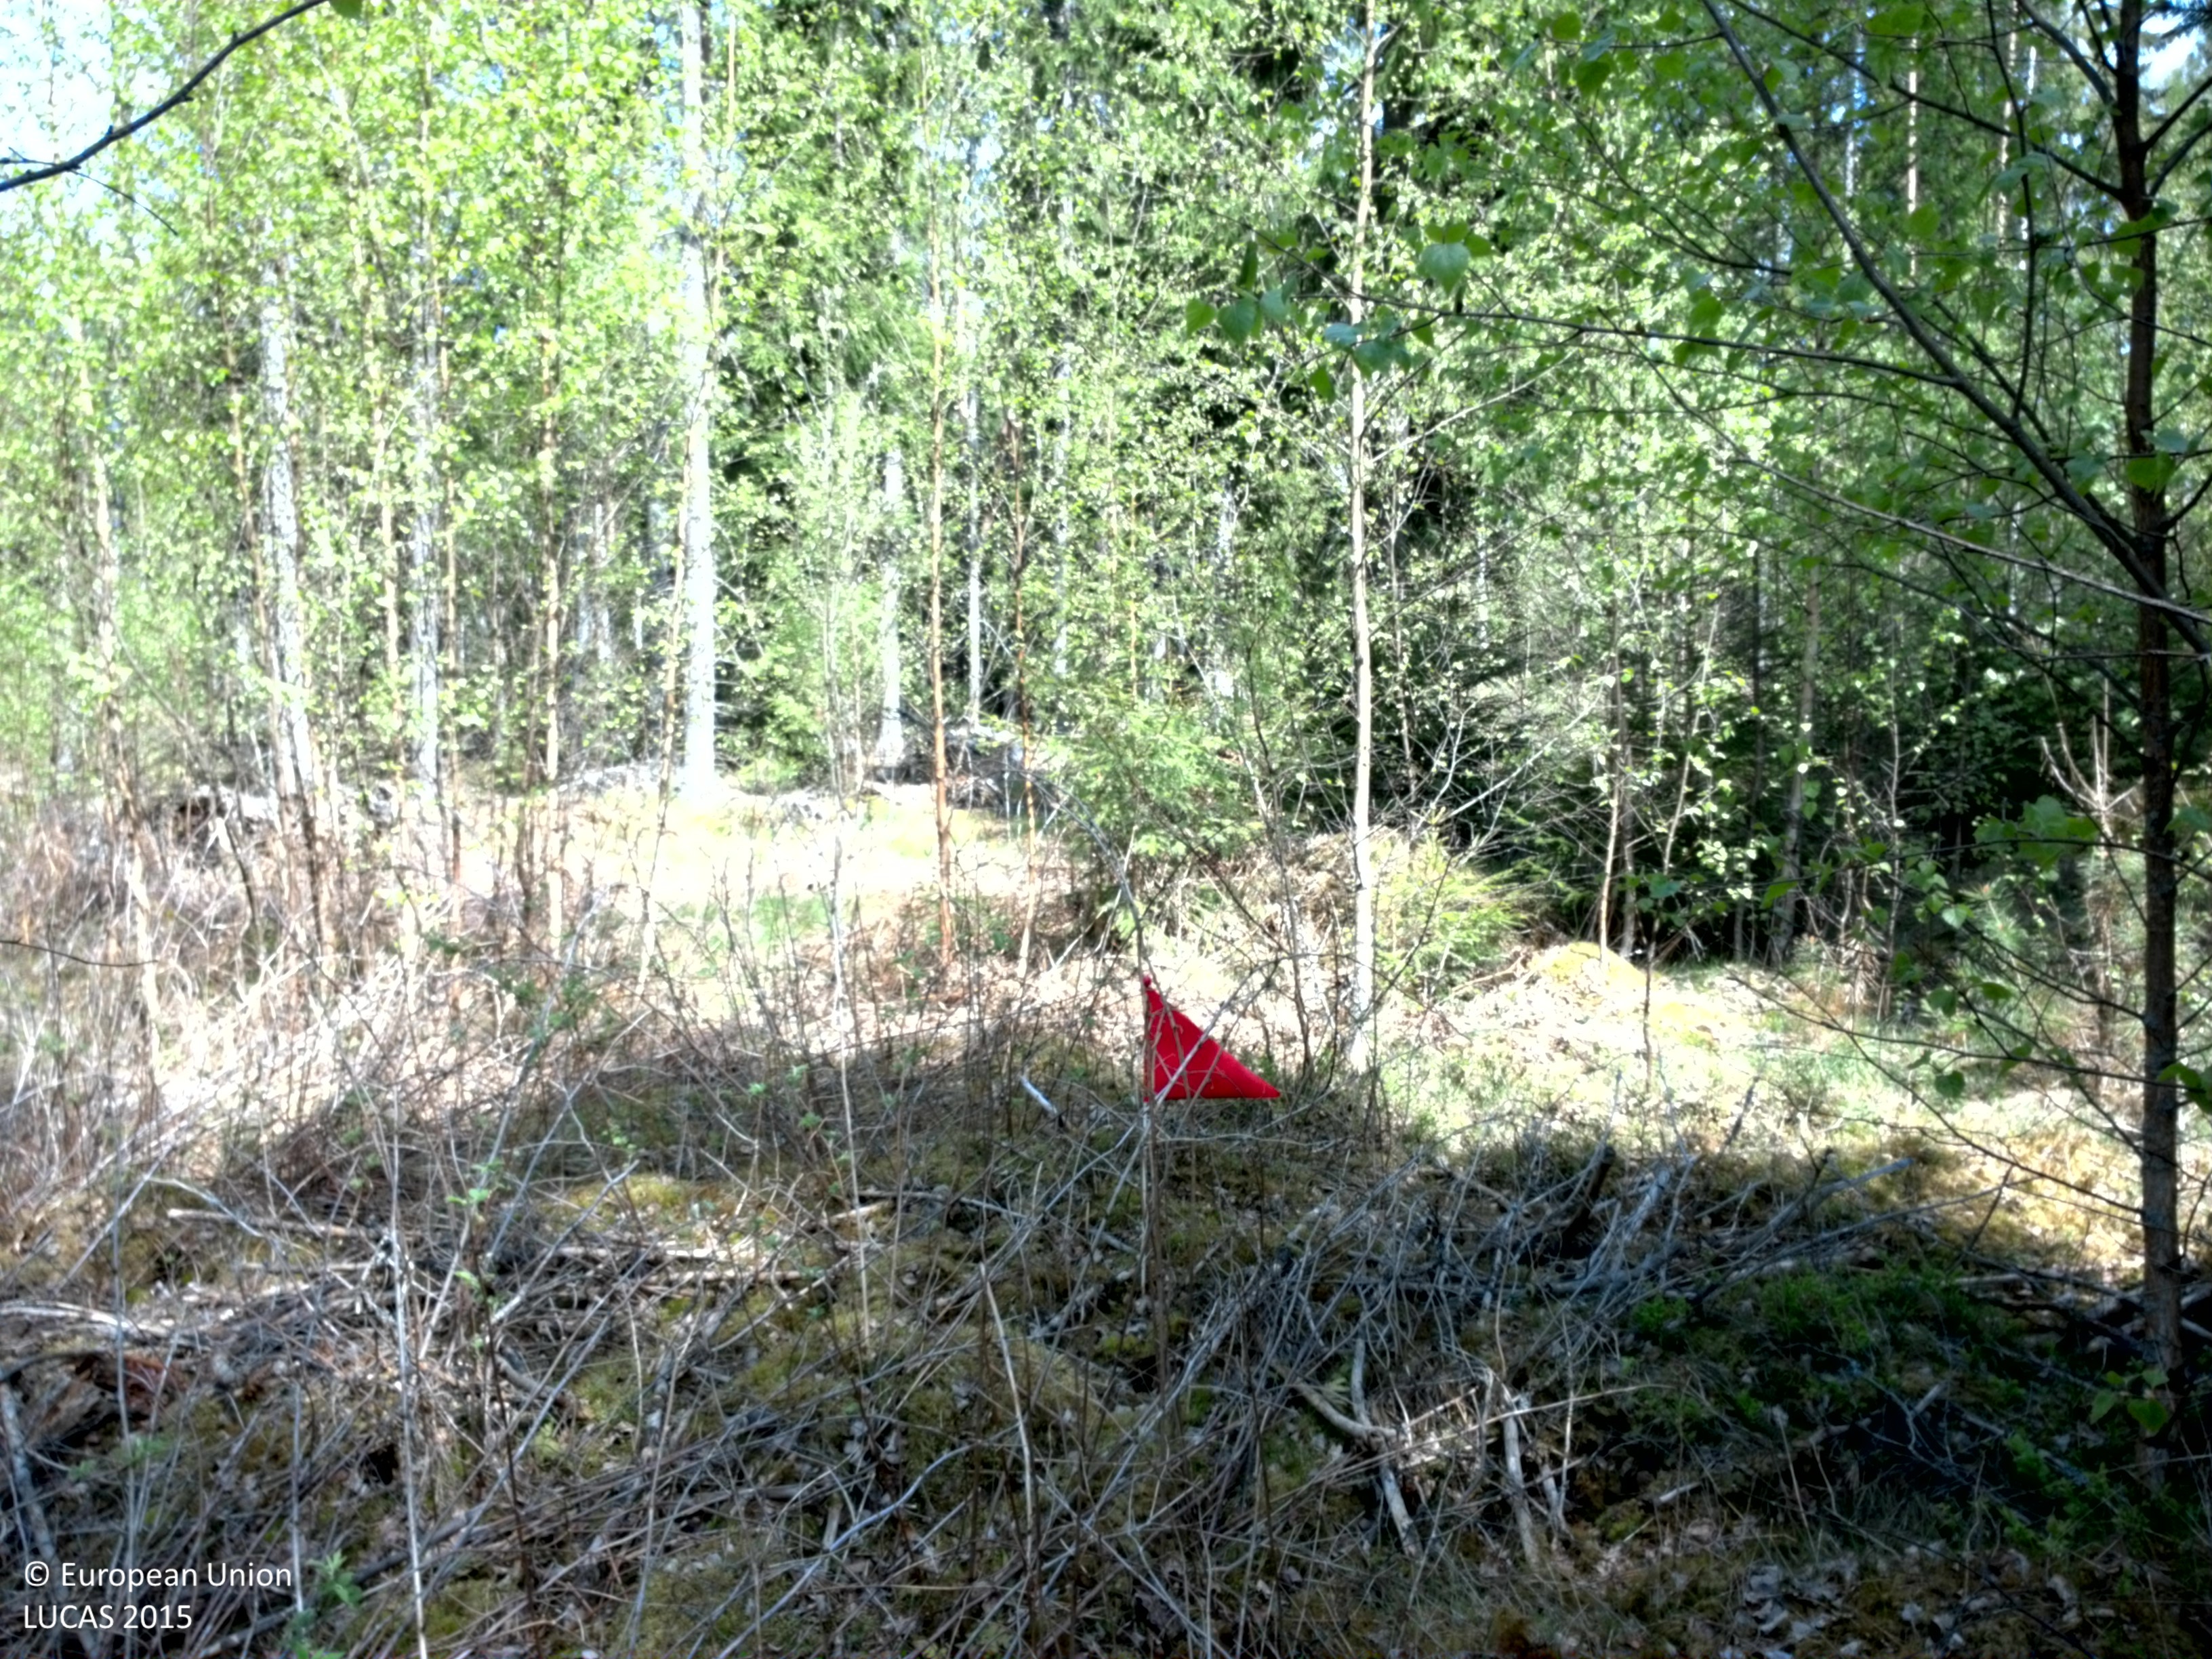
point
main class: Woodland
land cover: Spruce dominated mixed woodland
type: boreal forest
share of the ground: 50 - 75 %
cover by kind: broadleaved forest trees 45 %, coniferous forest trees 25 %, herbaceous plants 15 %, lichens and mosses 15 %
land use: Forestry
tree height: > 5 m
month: May
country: SE
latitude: 56.6728
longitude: 14.8445
